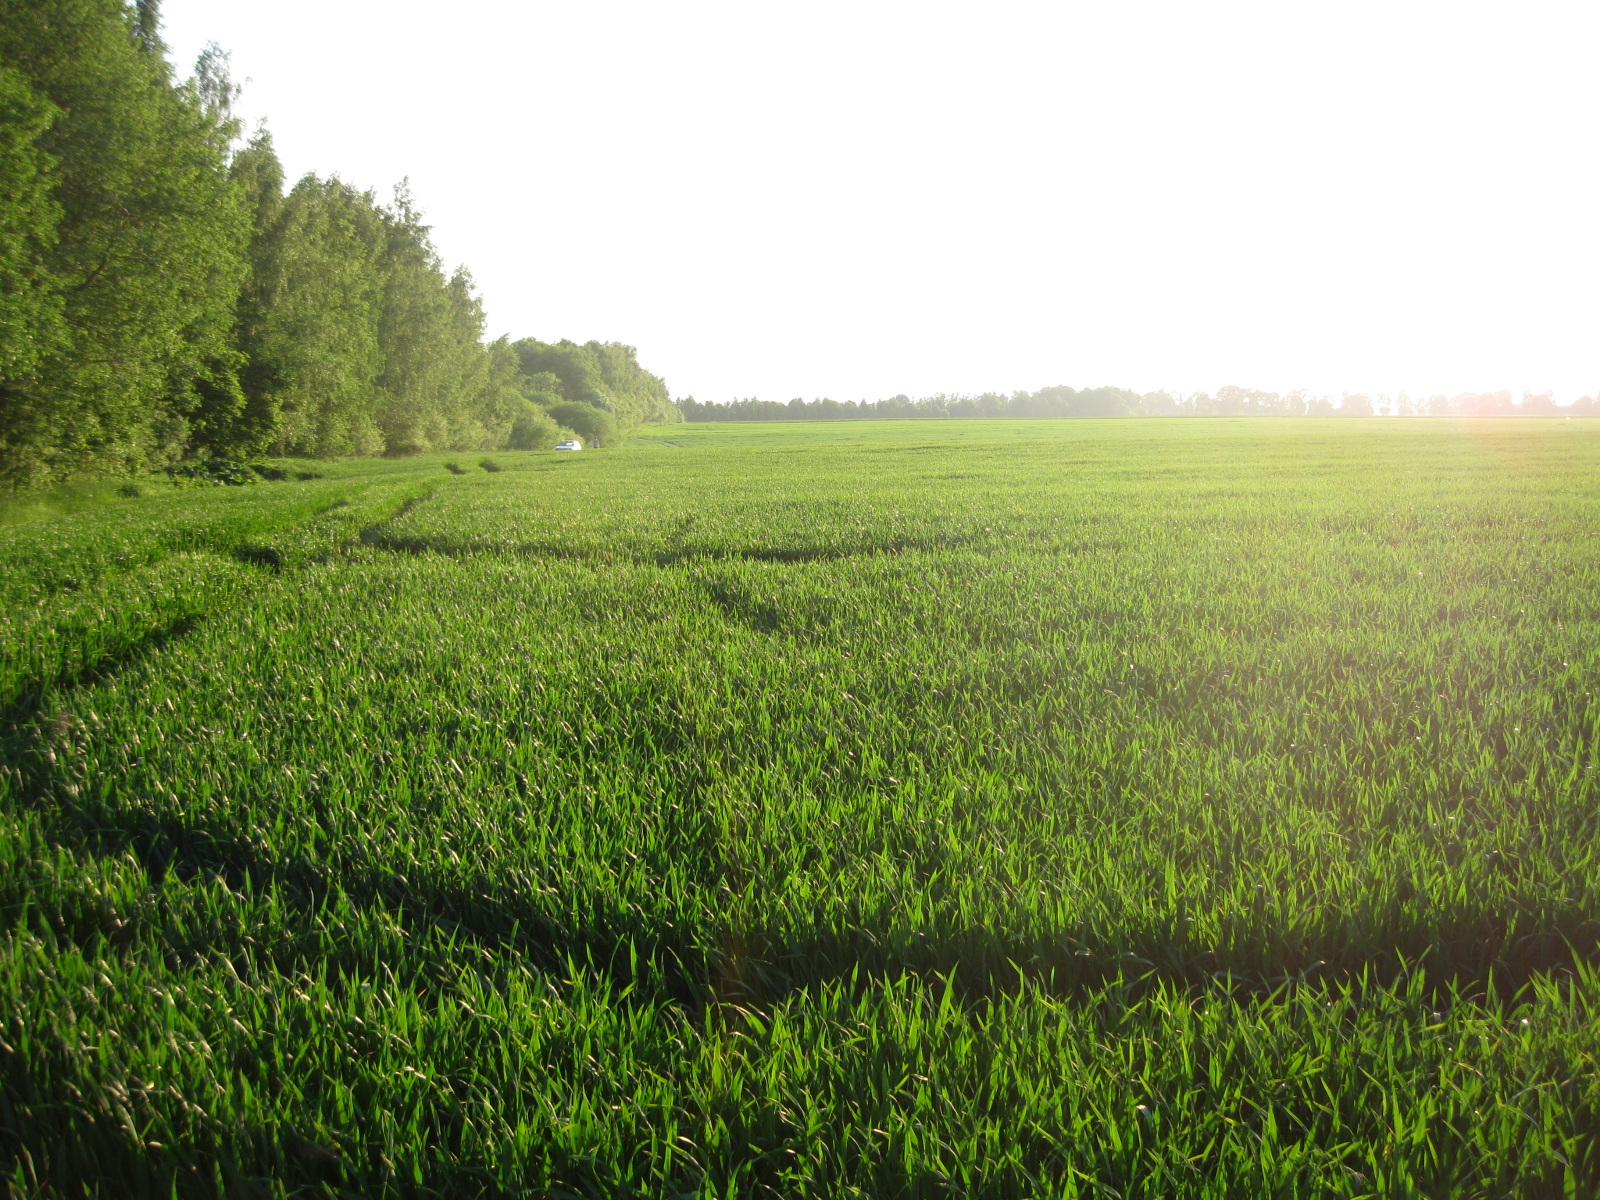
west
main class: Cropland
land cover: Common wheat
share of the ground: > 75 %
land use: Agriculture (excluding fallow land and kitchen gardens)
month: June
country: LT
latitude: 55.7446
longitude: 23.9948
